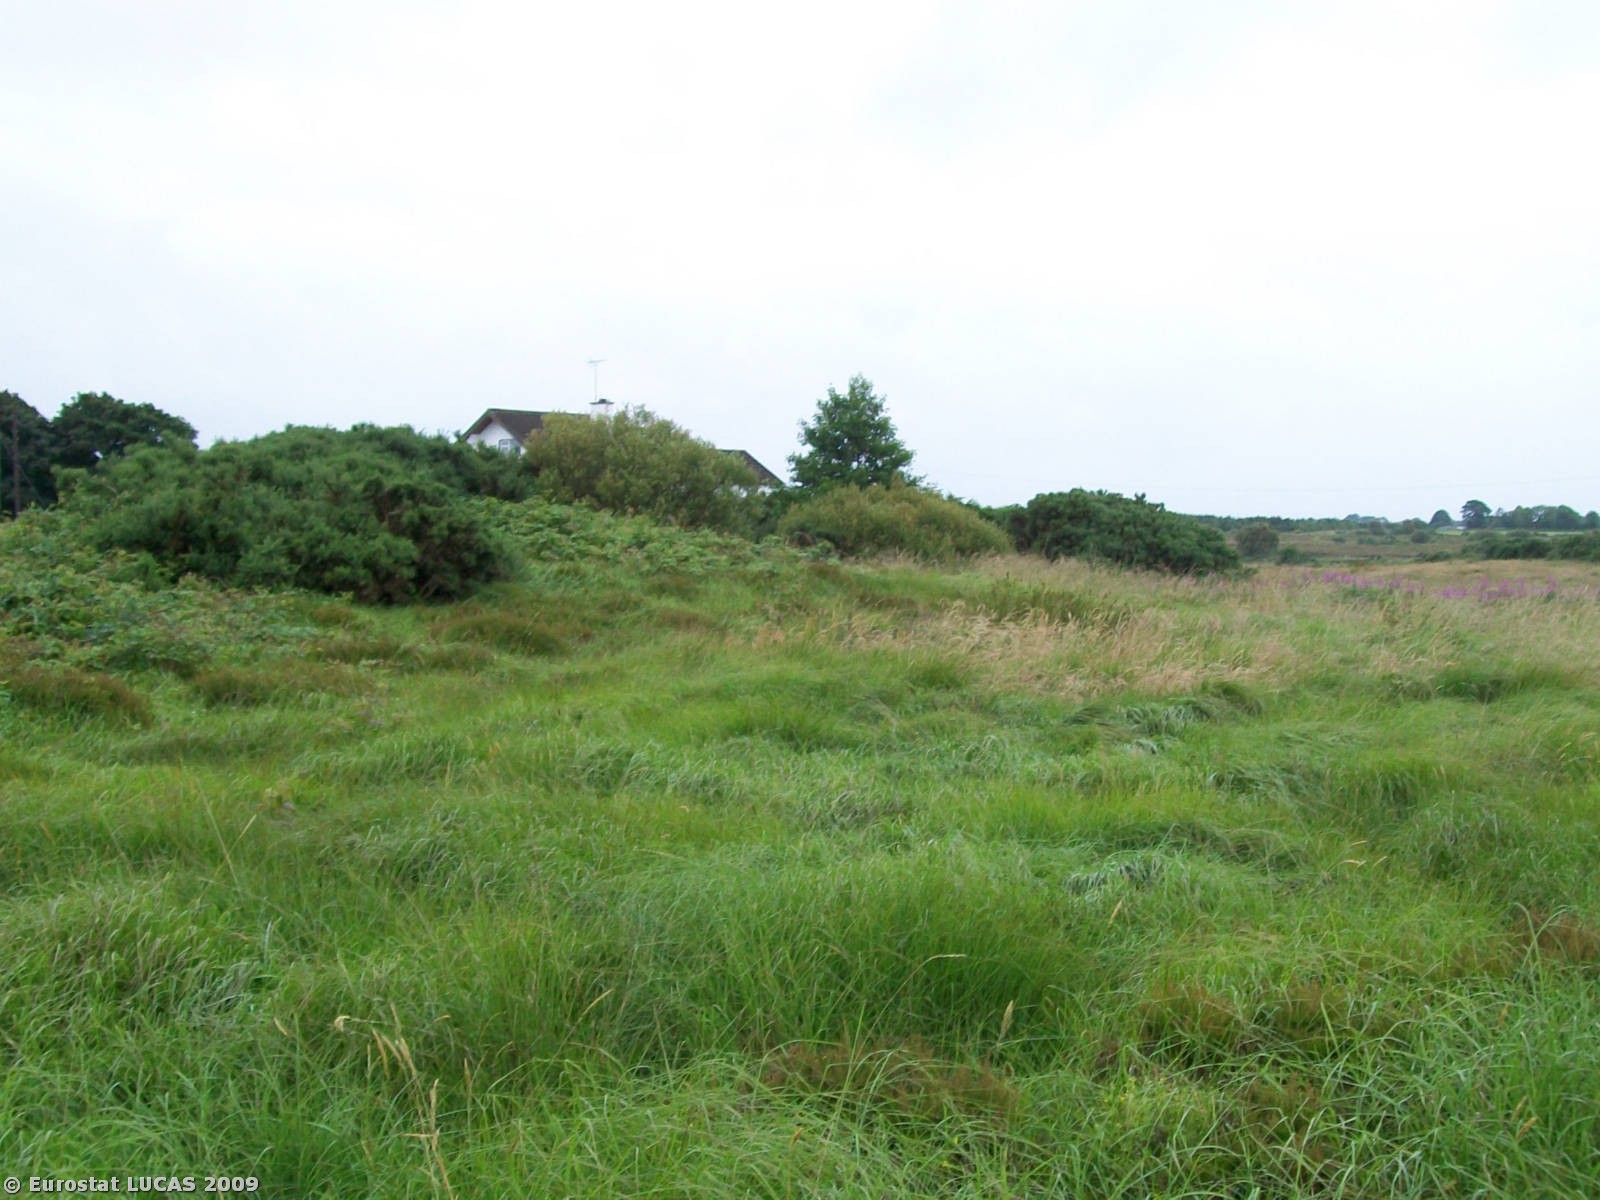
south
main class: Grassland
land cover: Grassland without tree/shrub cover
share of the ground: > 75 %
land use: Agriculture (excluding fallow land and kitchen gardens)
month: July
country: IE
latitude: 53.6474
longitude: -8.9225
